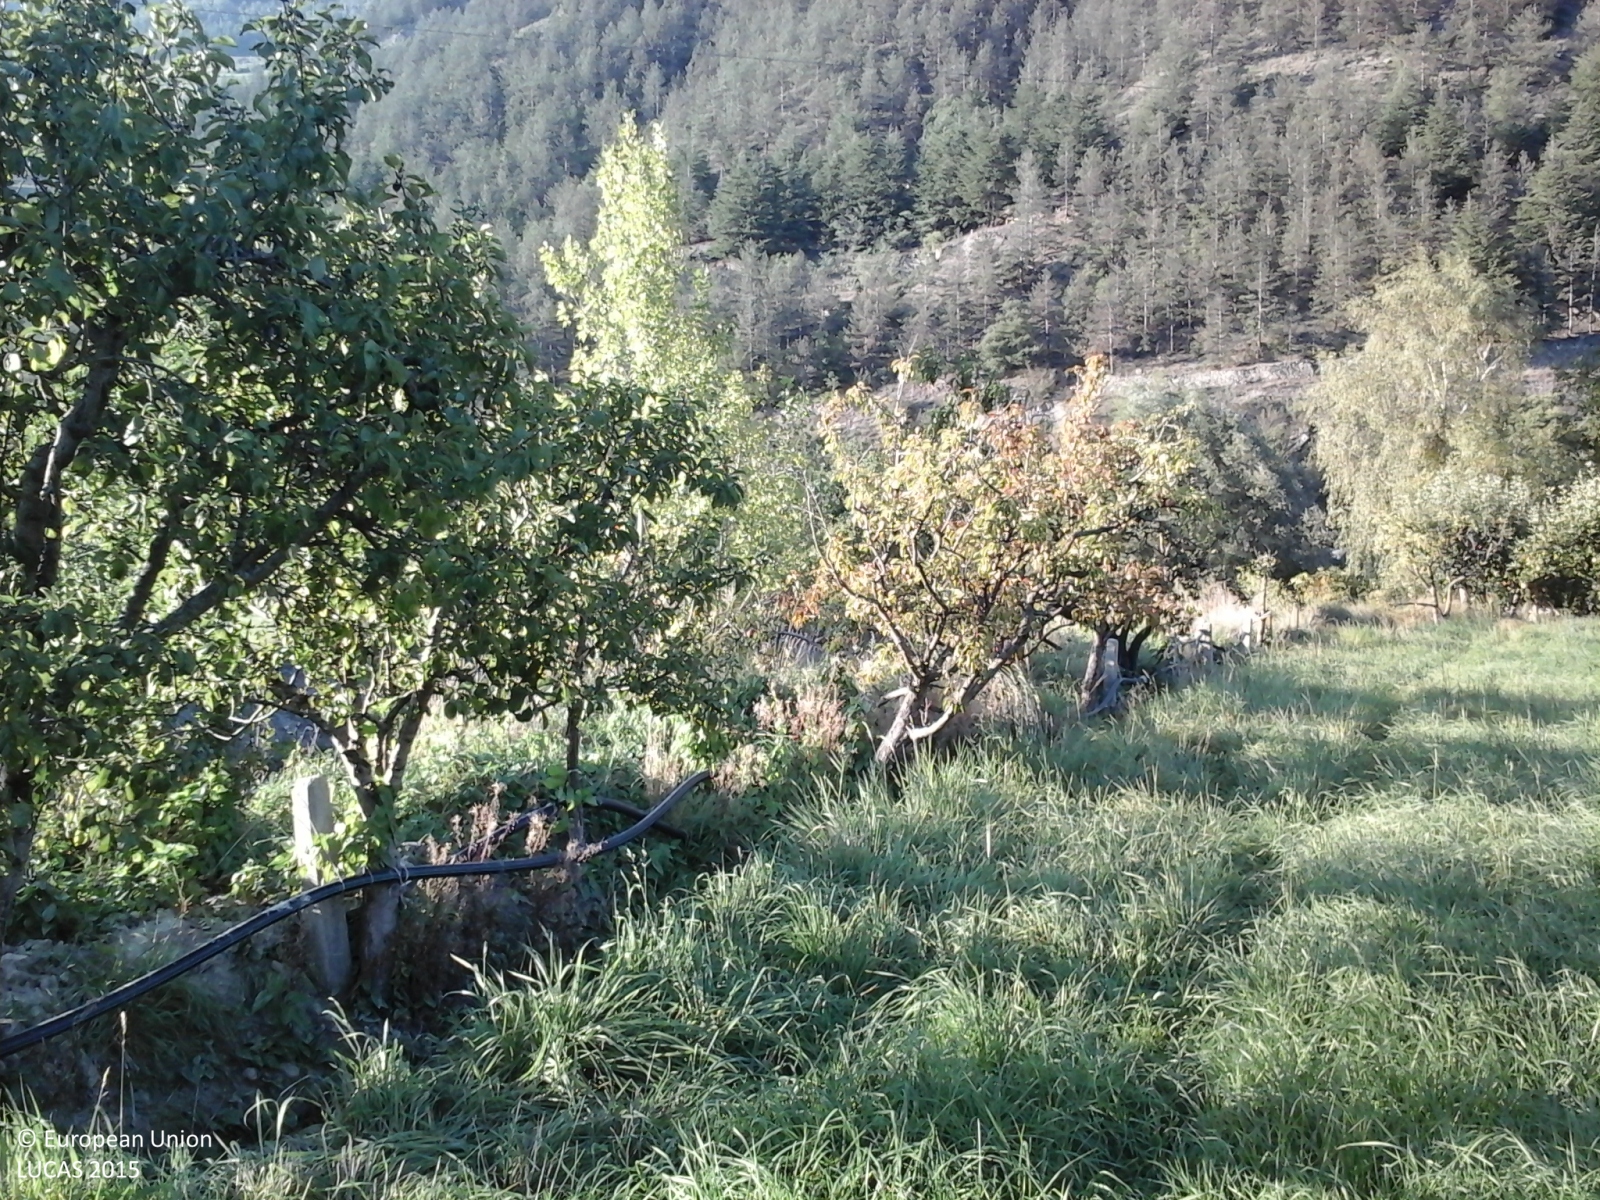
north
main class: Grassland
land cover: Grassland without tree/shrub cover
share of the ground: > 75 %
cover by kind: herbaceous plants 100 %
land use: Agriculture (excluding fallow land and kitchen gardens)
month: August
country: IT
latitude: 45.7015
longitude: 7.1911
